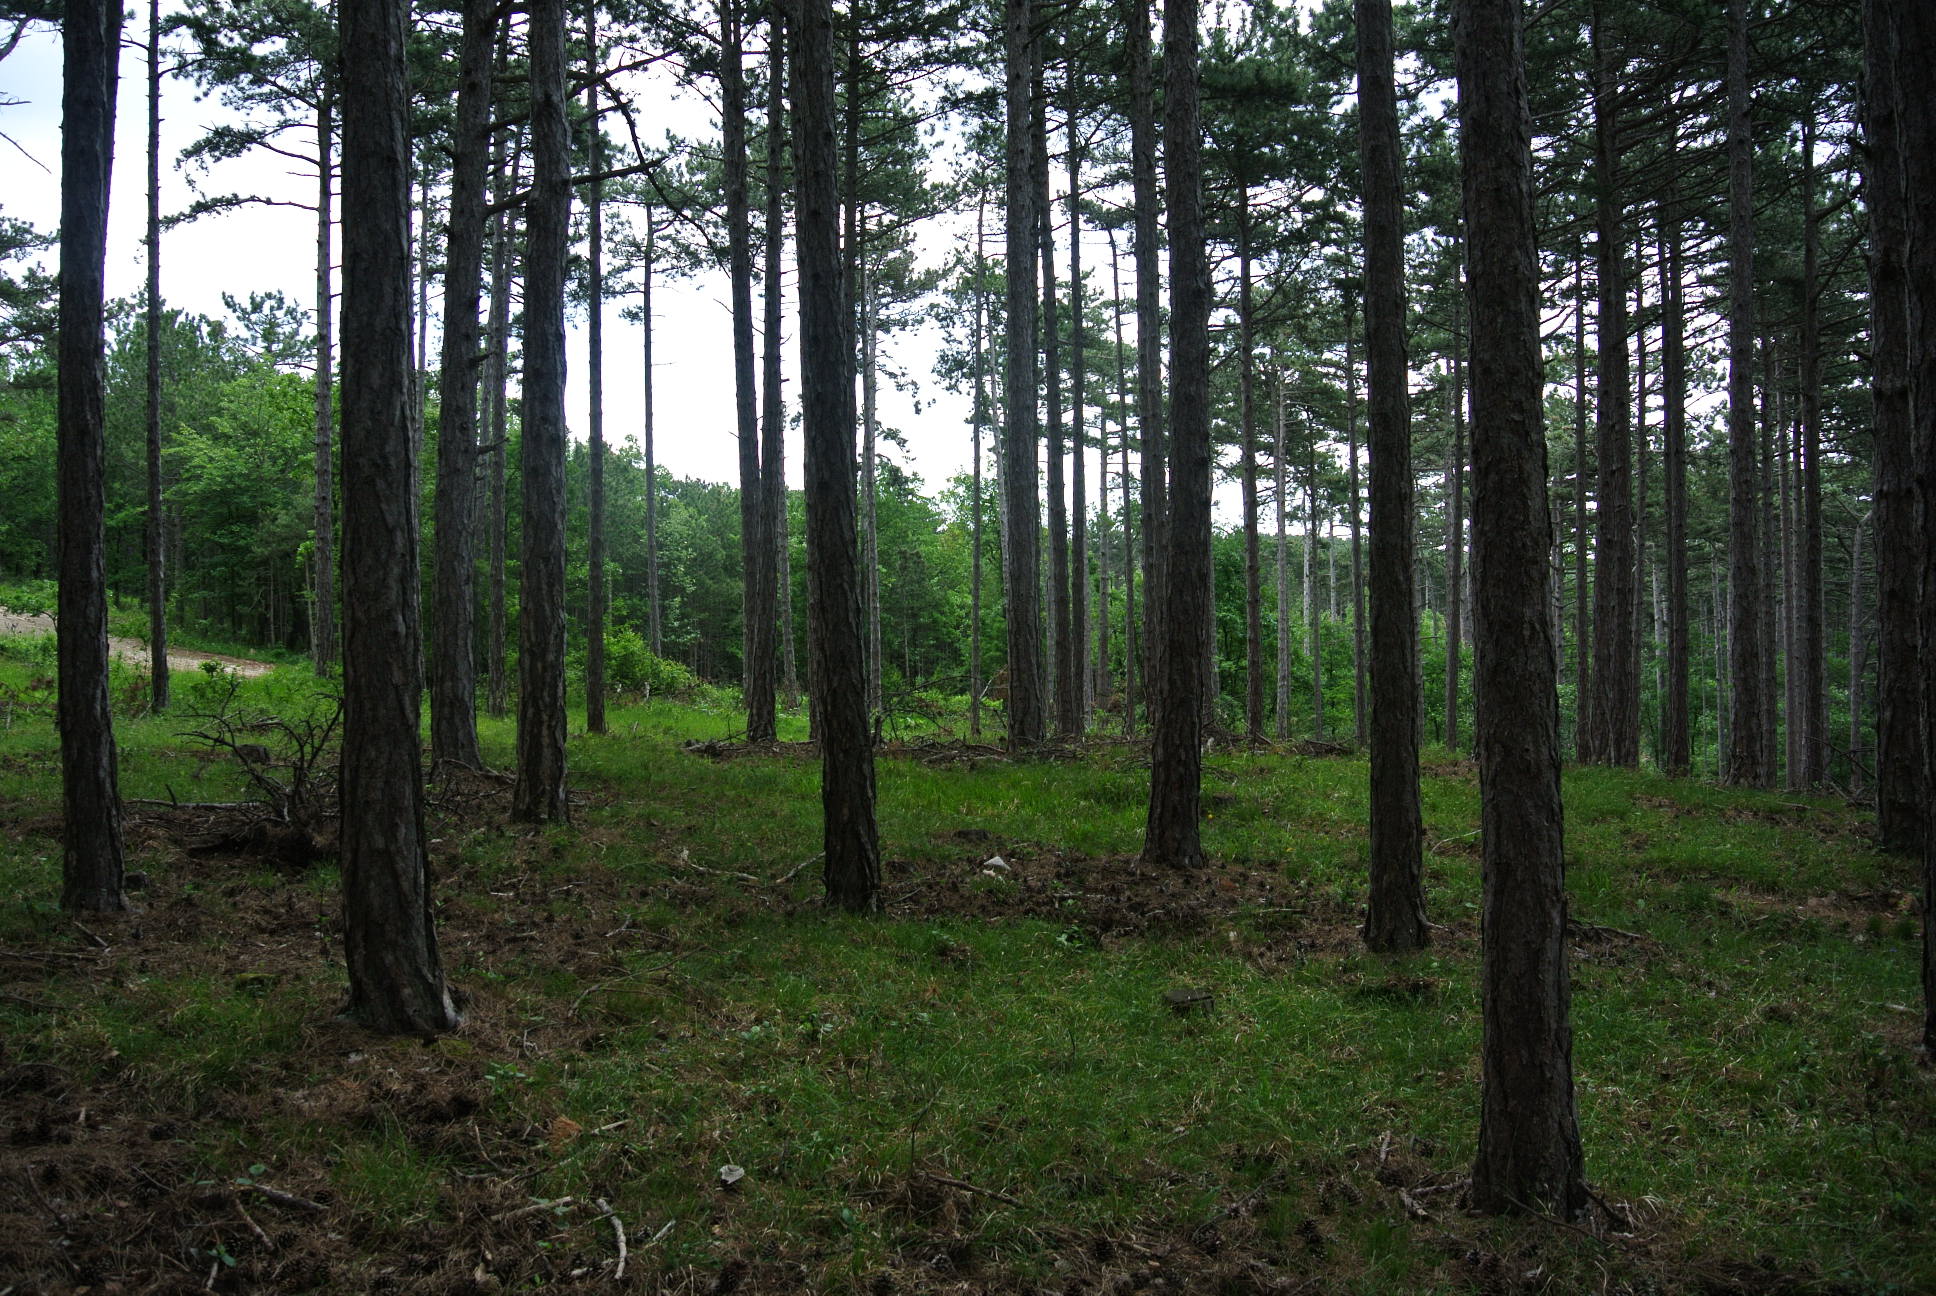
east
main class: Woodland
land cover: Pine dominated coniferous woodland
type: alpine coniferous forest
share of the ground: > 75 %
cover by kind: coniferous forest trees 85 %, herbaceous plants 15 %
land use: Forestry
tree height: > 5 m
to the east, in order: Pine dominated coniferous woodland; Tracks; Pine dominated mixed woodland
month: May
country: AT
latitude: 47.8196
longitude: 16.1071
